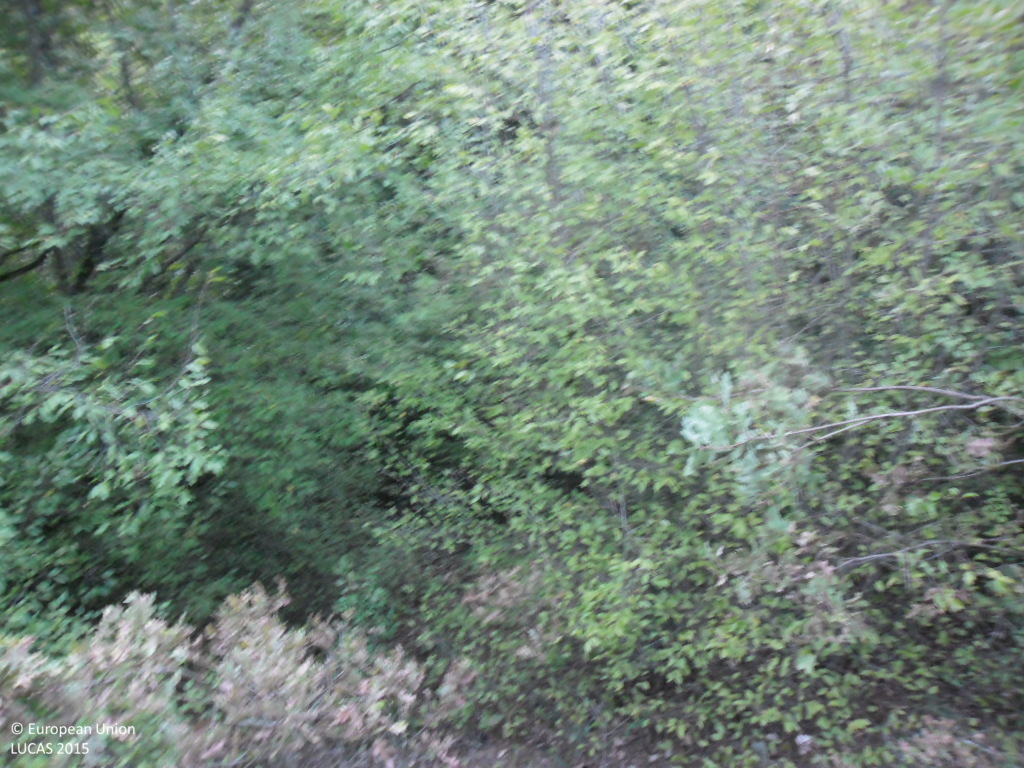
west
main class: Woodland
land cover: Broadleaved woodland
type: mesophytic deciduous forest
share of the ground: > 75 %
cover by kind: broadleaved forest trees 75 %, herbaceous plants 15 %, shrubs 5 %, unconsolidated bare surface 5 %
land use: Forestry
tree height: < 5 m
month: October
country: BG
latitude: 42.0692
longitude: 22.9916
